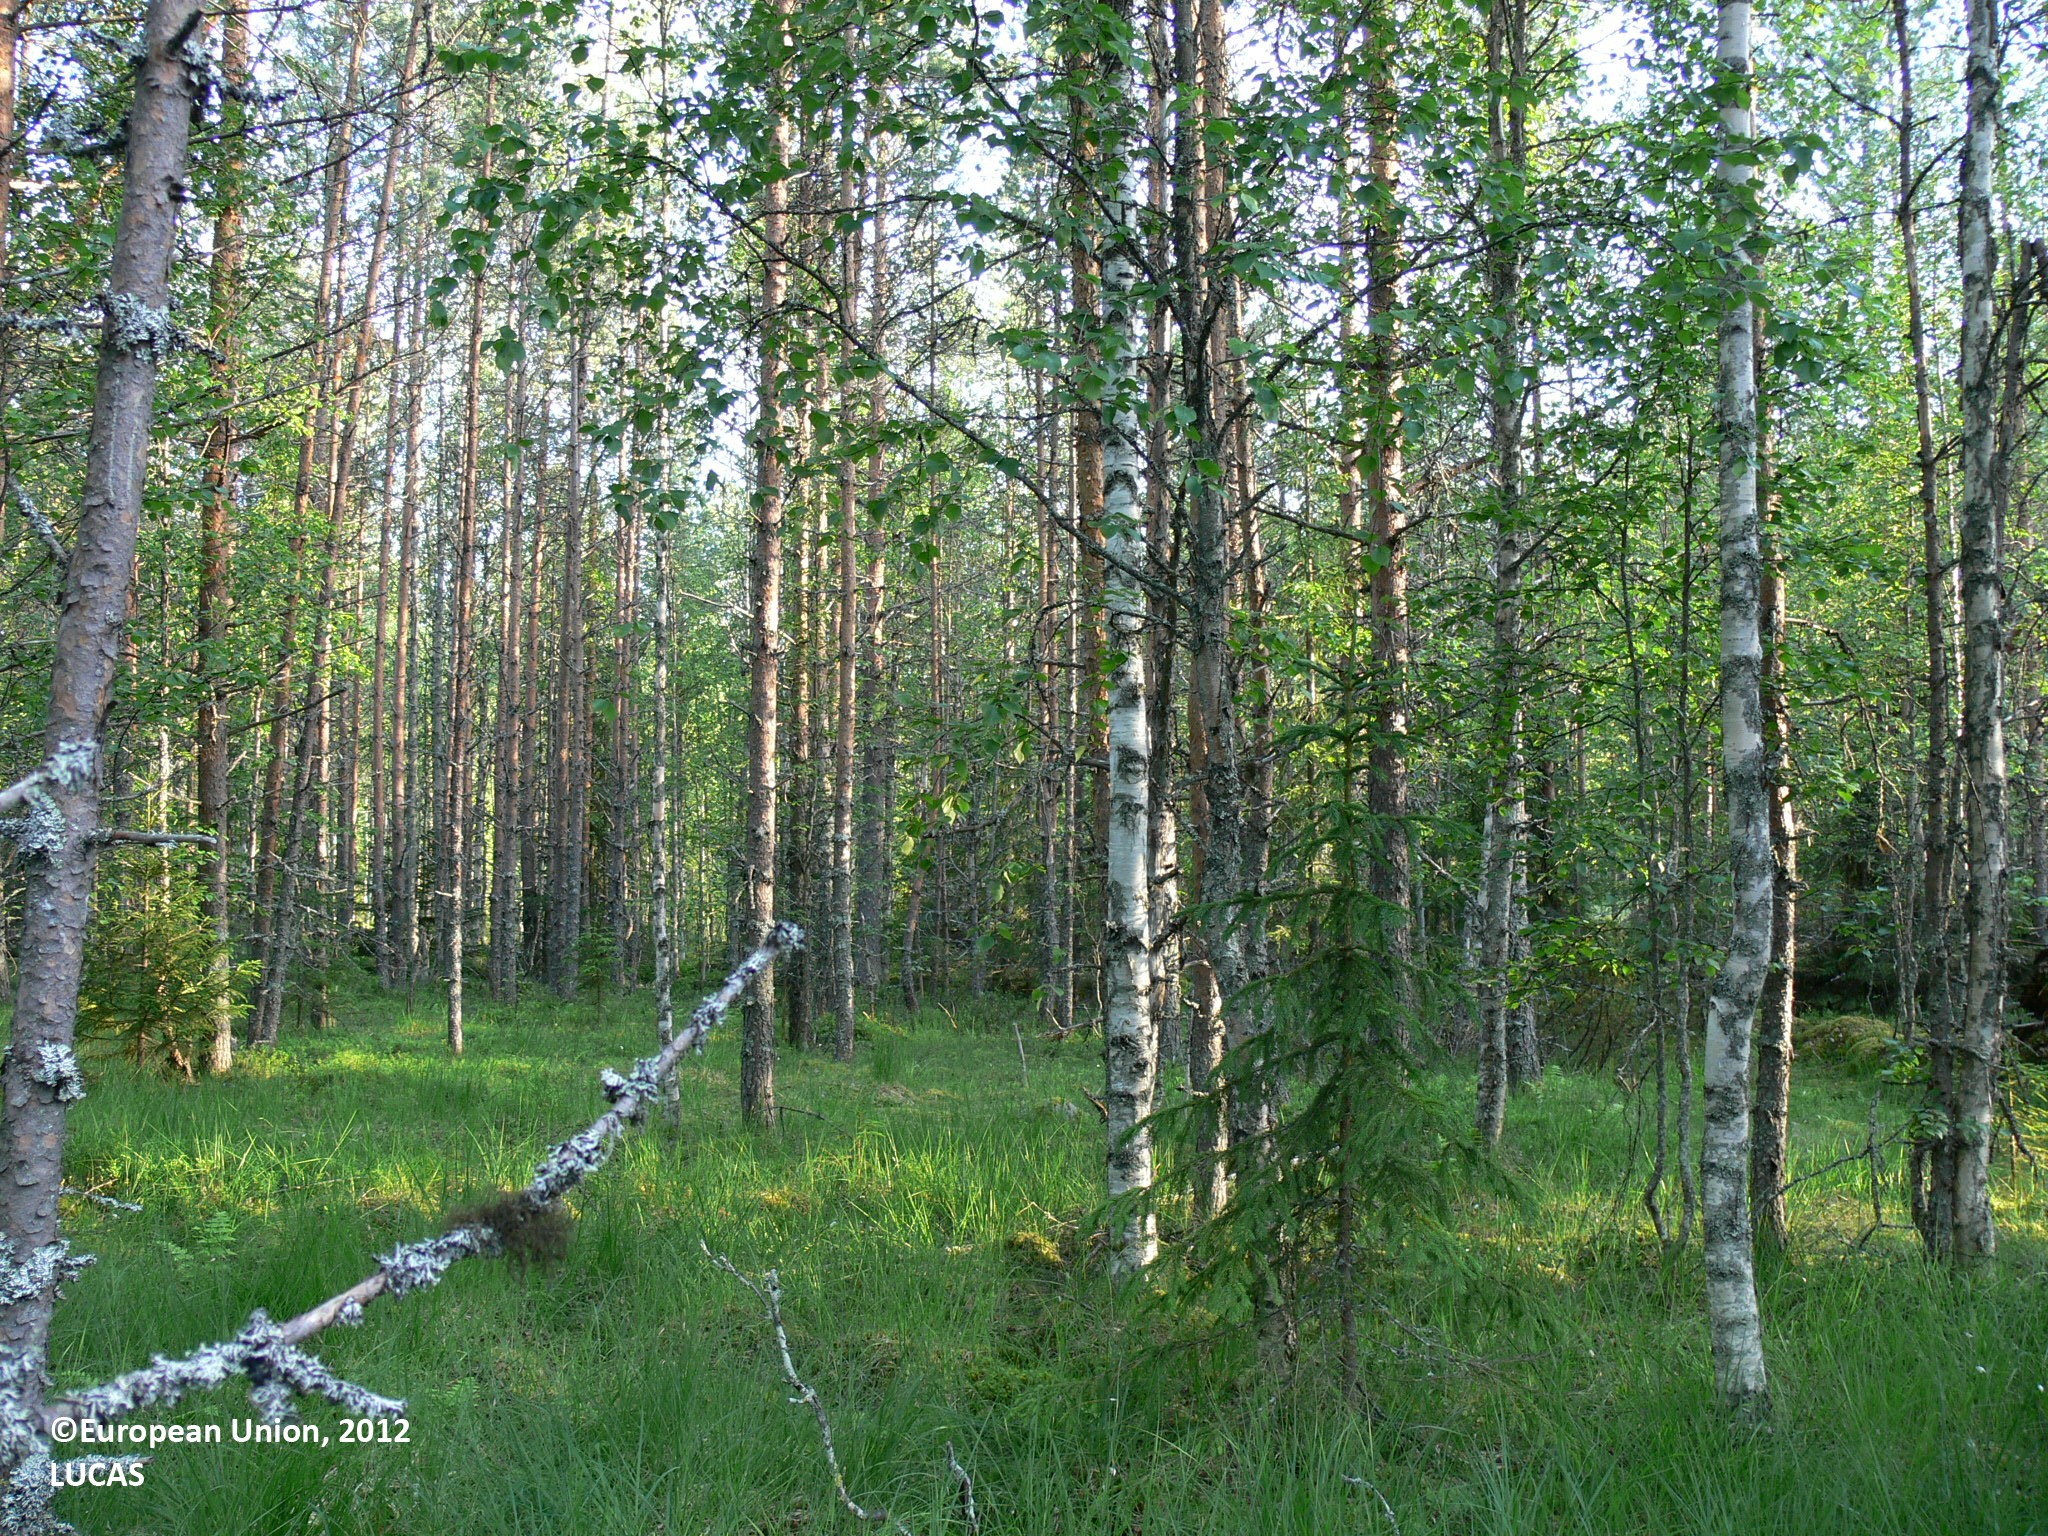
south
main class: Woodland
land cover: Pine dominated mixed woodland
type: boreal forest
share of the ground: > 75 %
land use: Forestry
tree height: > 5 m
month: July
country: FI
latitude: 63.3262
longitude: 30.8331
